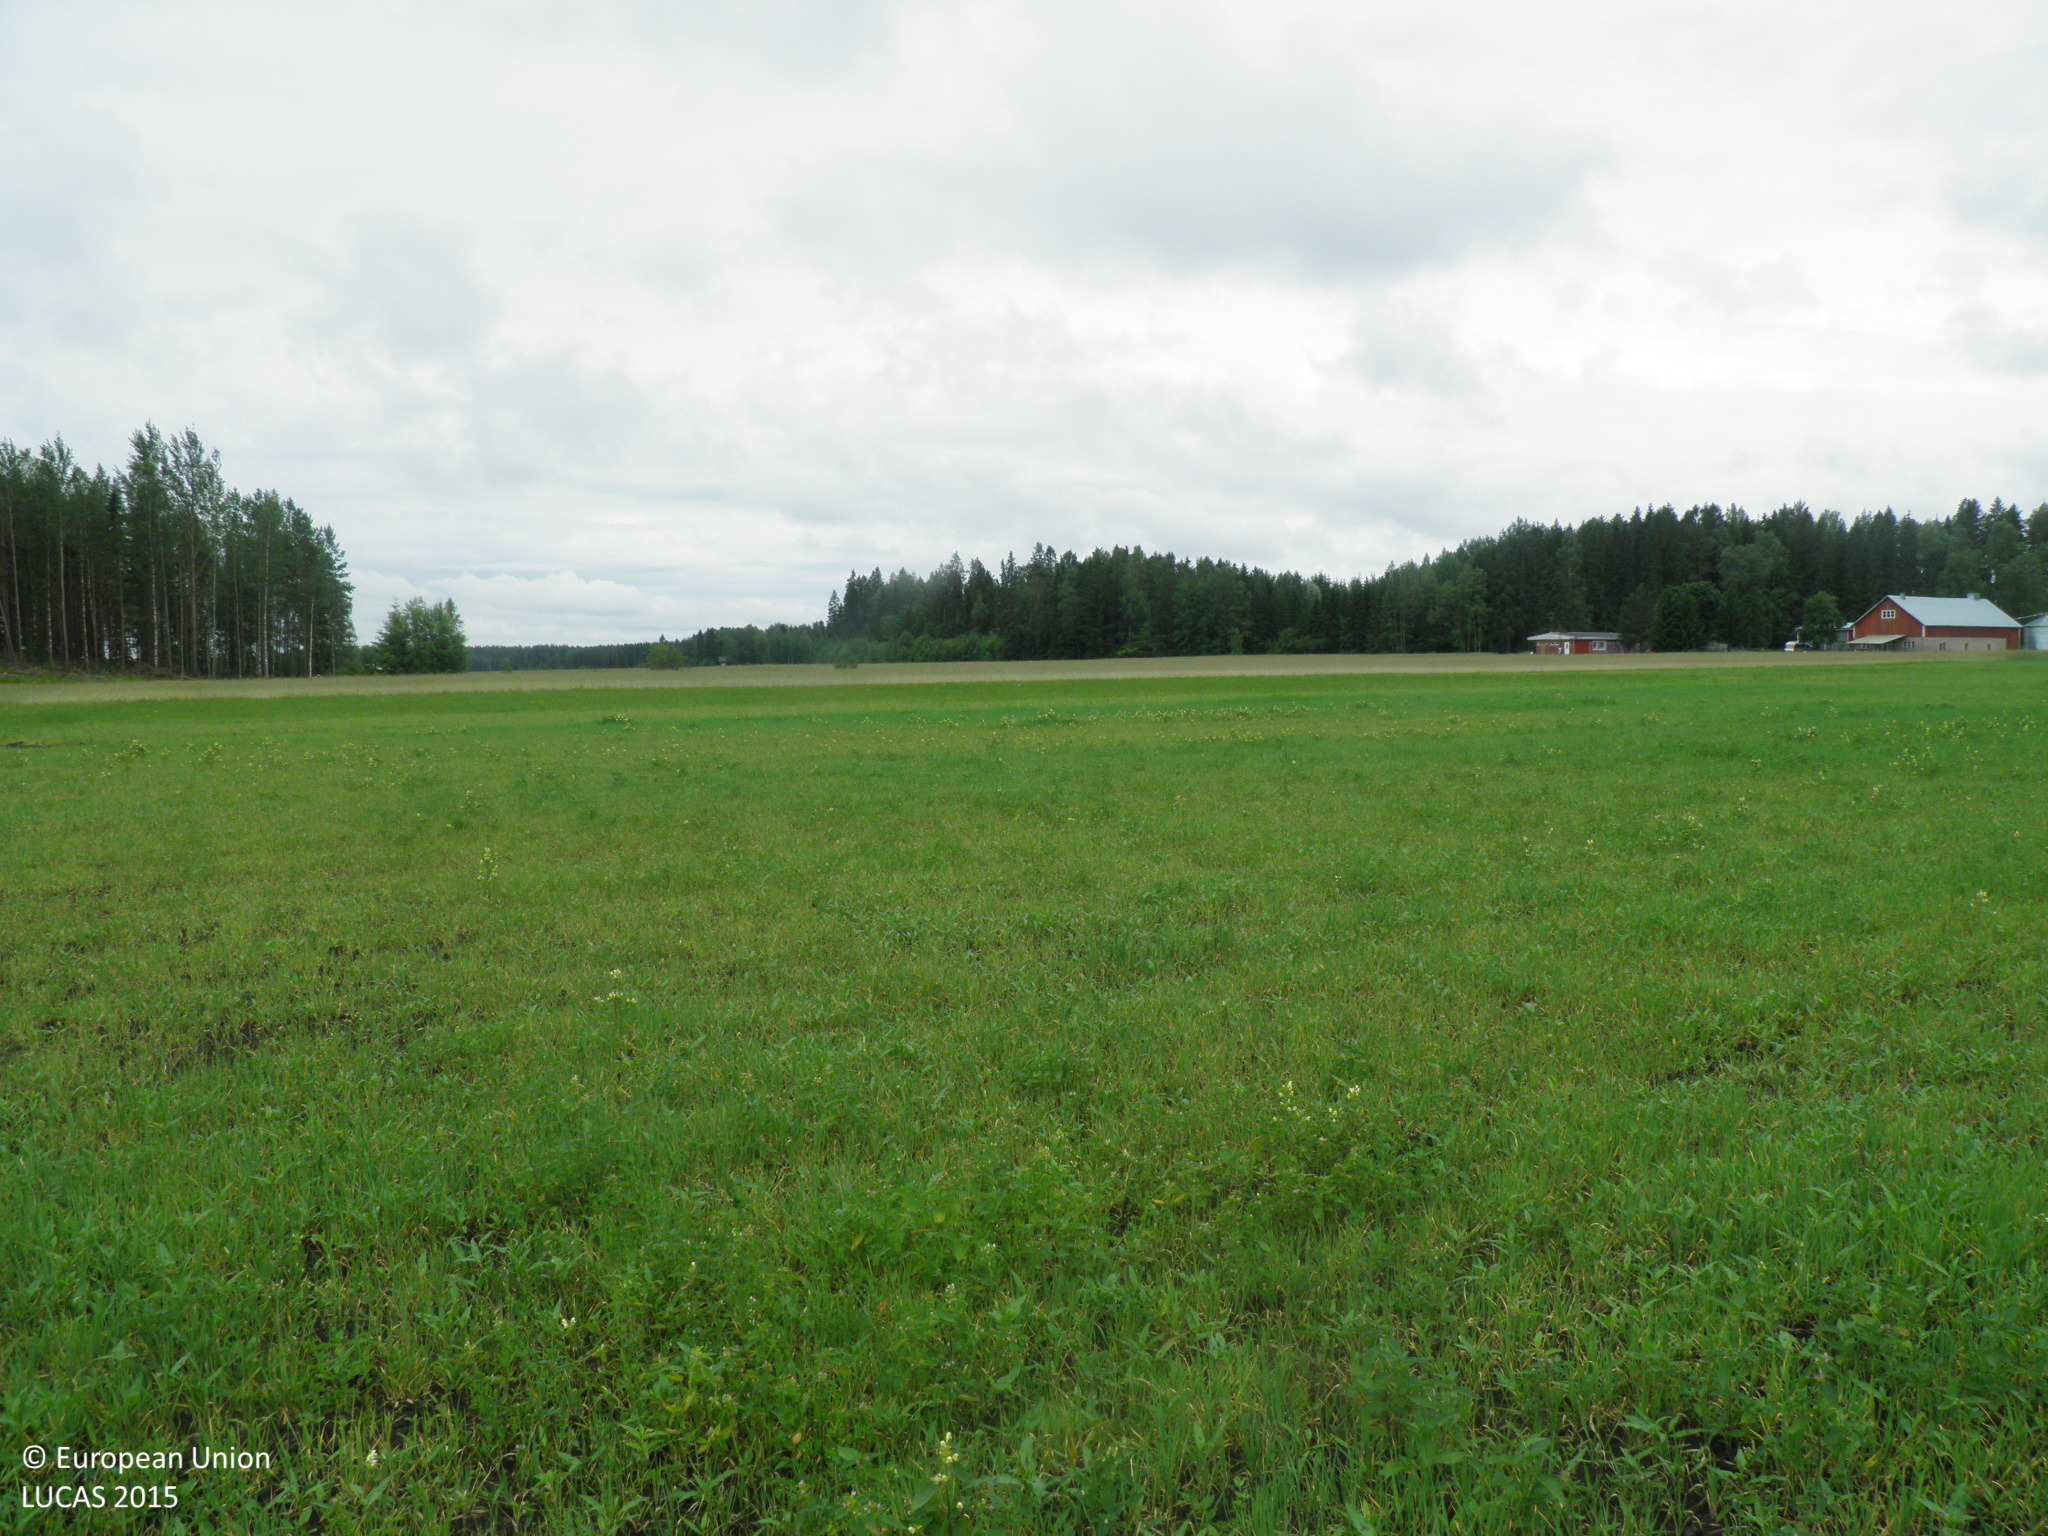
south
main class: Cropland
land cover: Barley
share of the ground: > 75 %
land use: Agriculture (excluding fallow land and kitchen gardens)
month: July
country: FI
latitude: 60.6621
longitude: 22.7156
